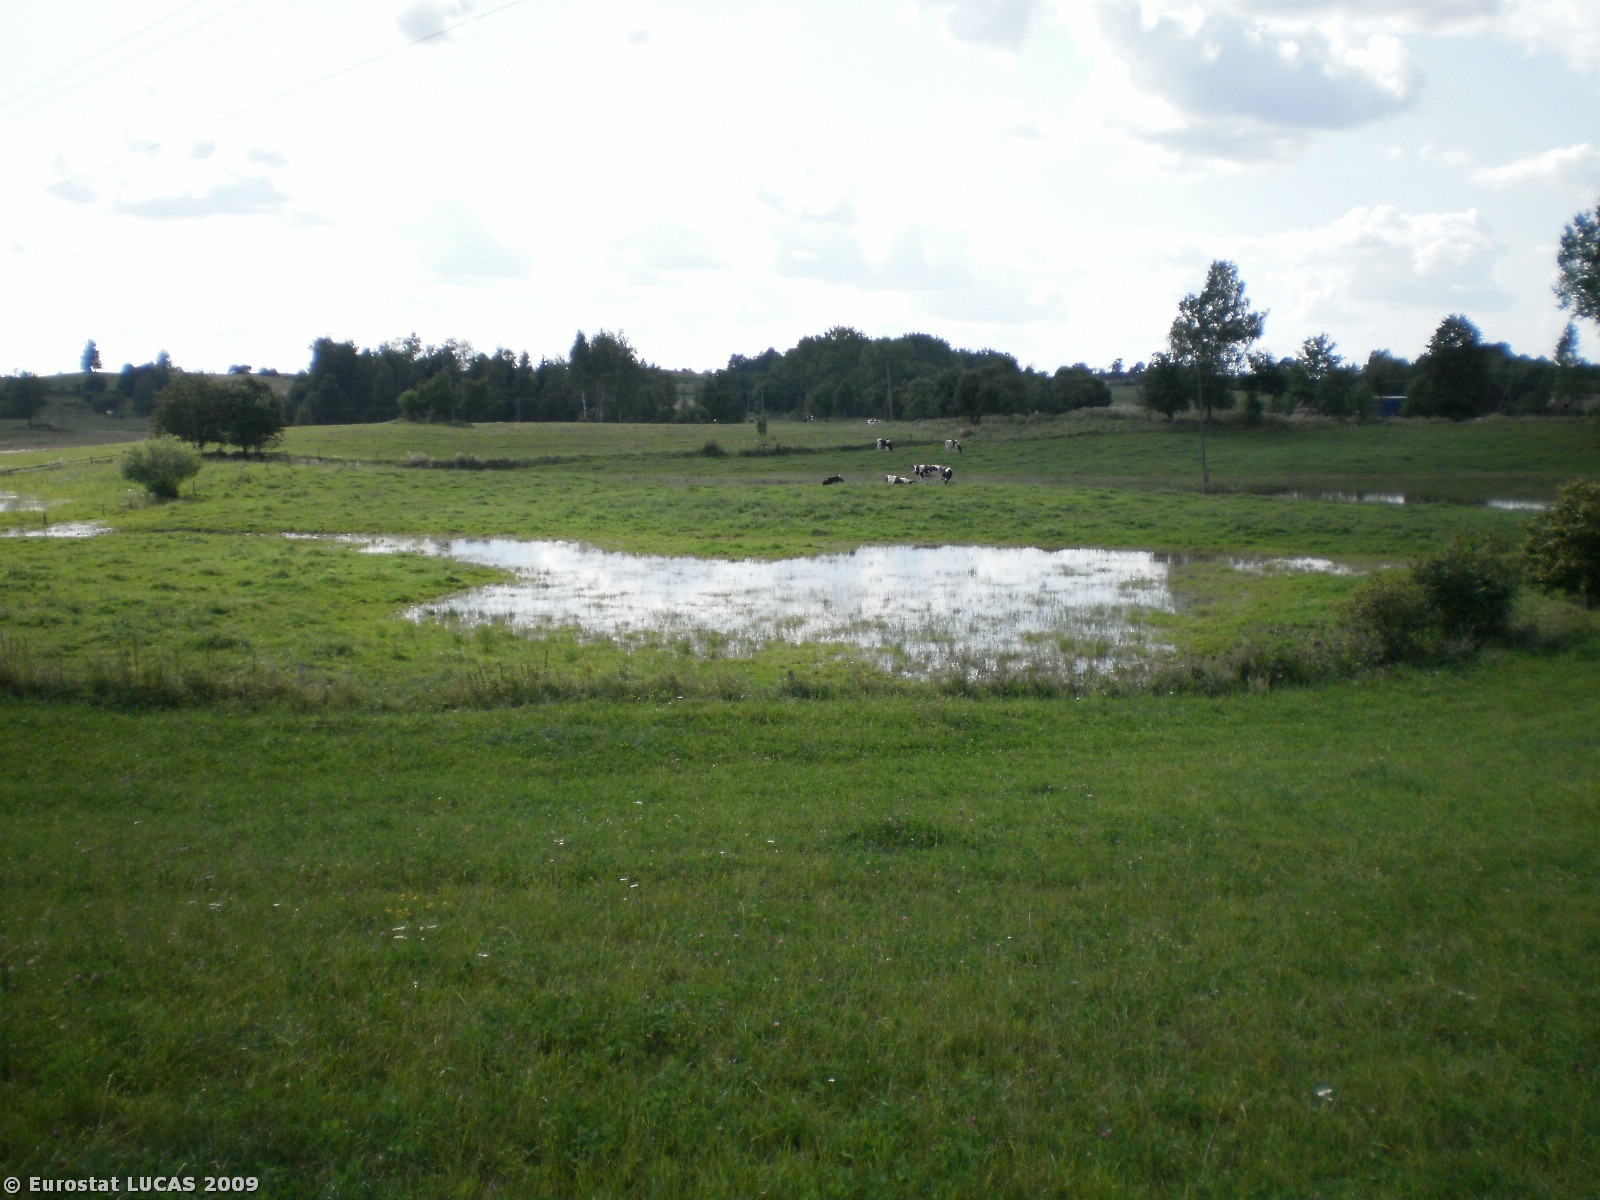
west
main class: Grassland
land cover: Grassland without tree/shrub cover
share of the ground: > 75 %
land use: Agriculture (excluding fallow land and kitchen gardens)
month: August
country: PL
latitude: 53.9207
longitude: 21.1449
